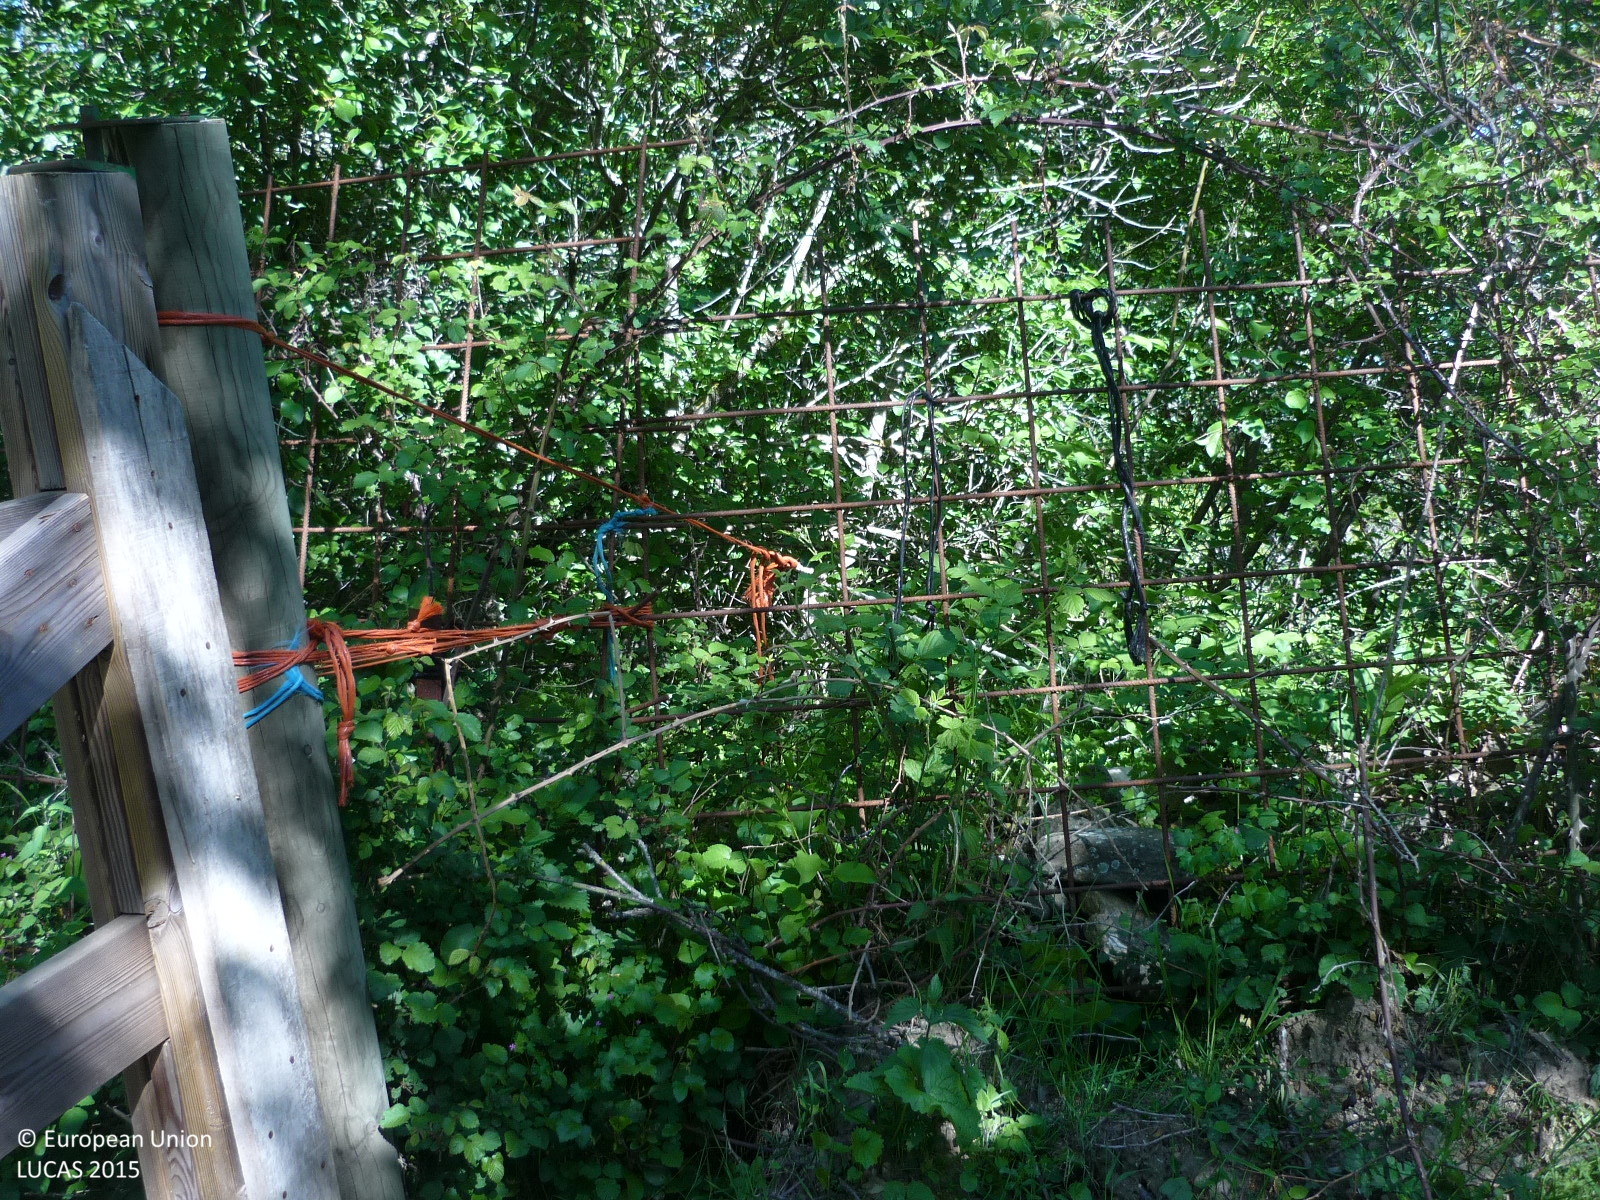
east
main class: Grassland
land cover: Grassland without tree/shrub cover
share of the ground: > 75 %
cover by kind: herbaceous plants 95 %, shrubs 5 %
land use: Agriculture (excluding fallow land and kitchen gardens)
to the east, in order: Grassland without tree/shrub cover; Grassland with sparse tree/shrub cover; Dry stone walls; Grassland with sparse tree/shrub cover
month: May
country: ES
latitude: 41.1555
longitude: -3.4011
